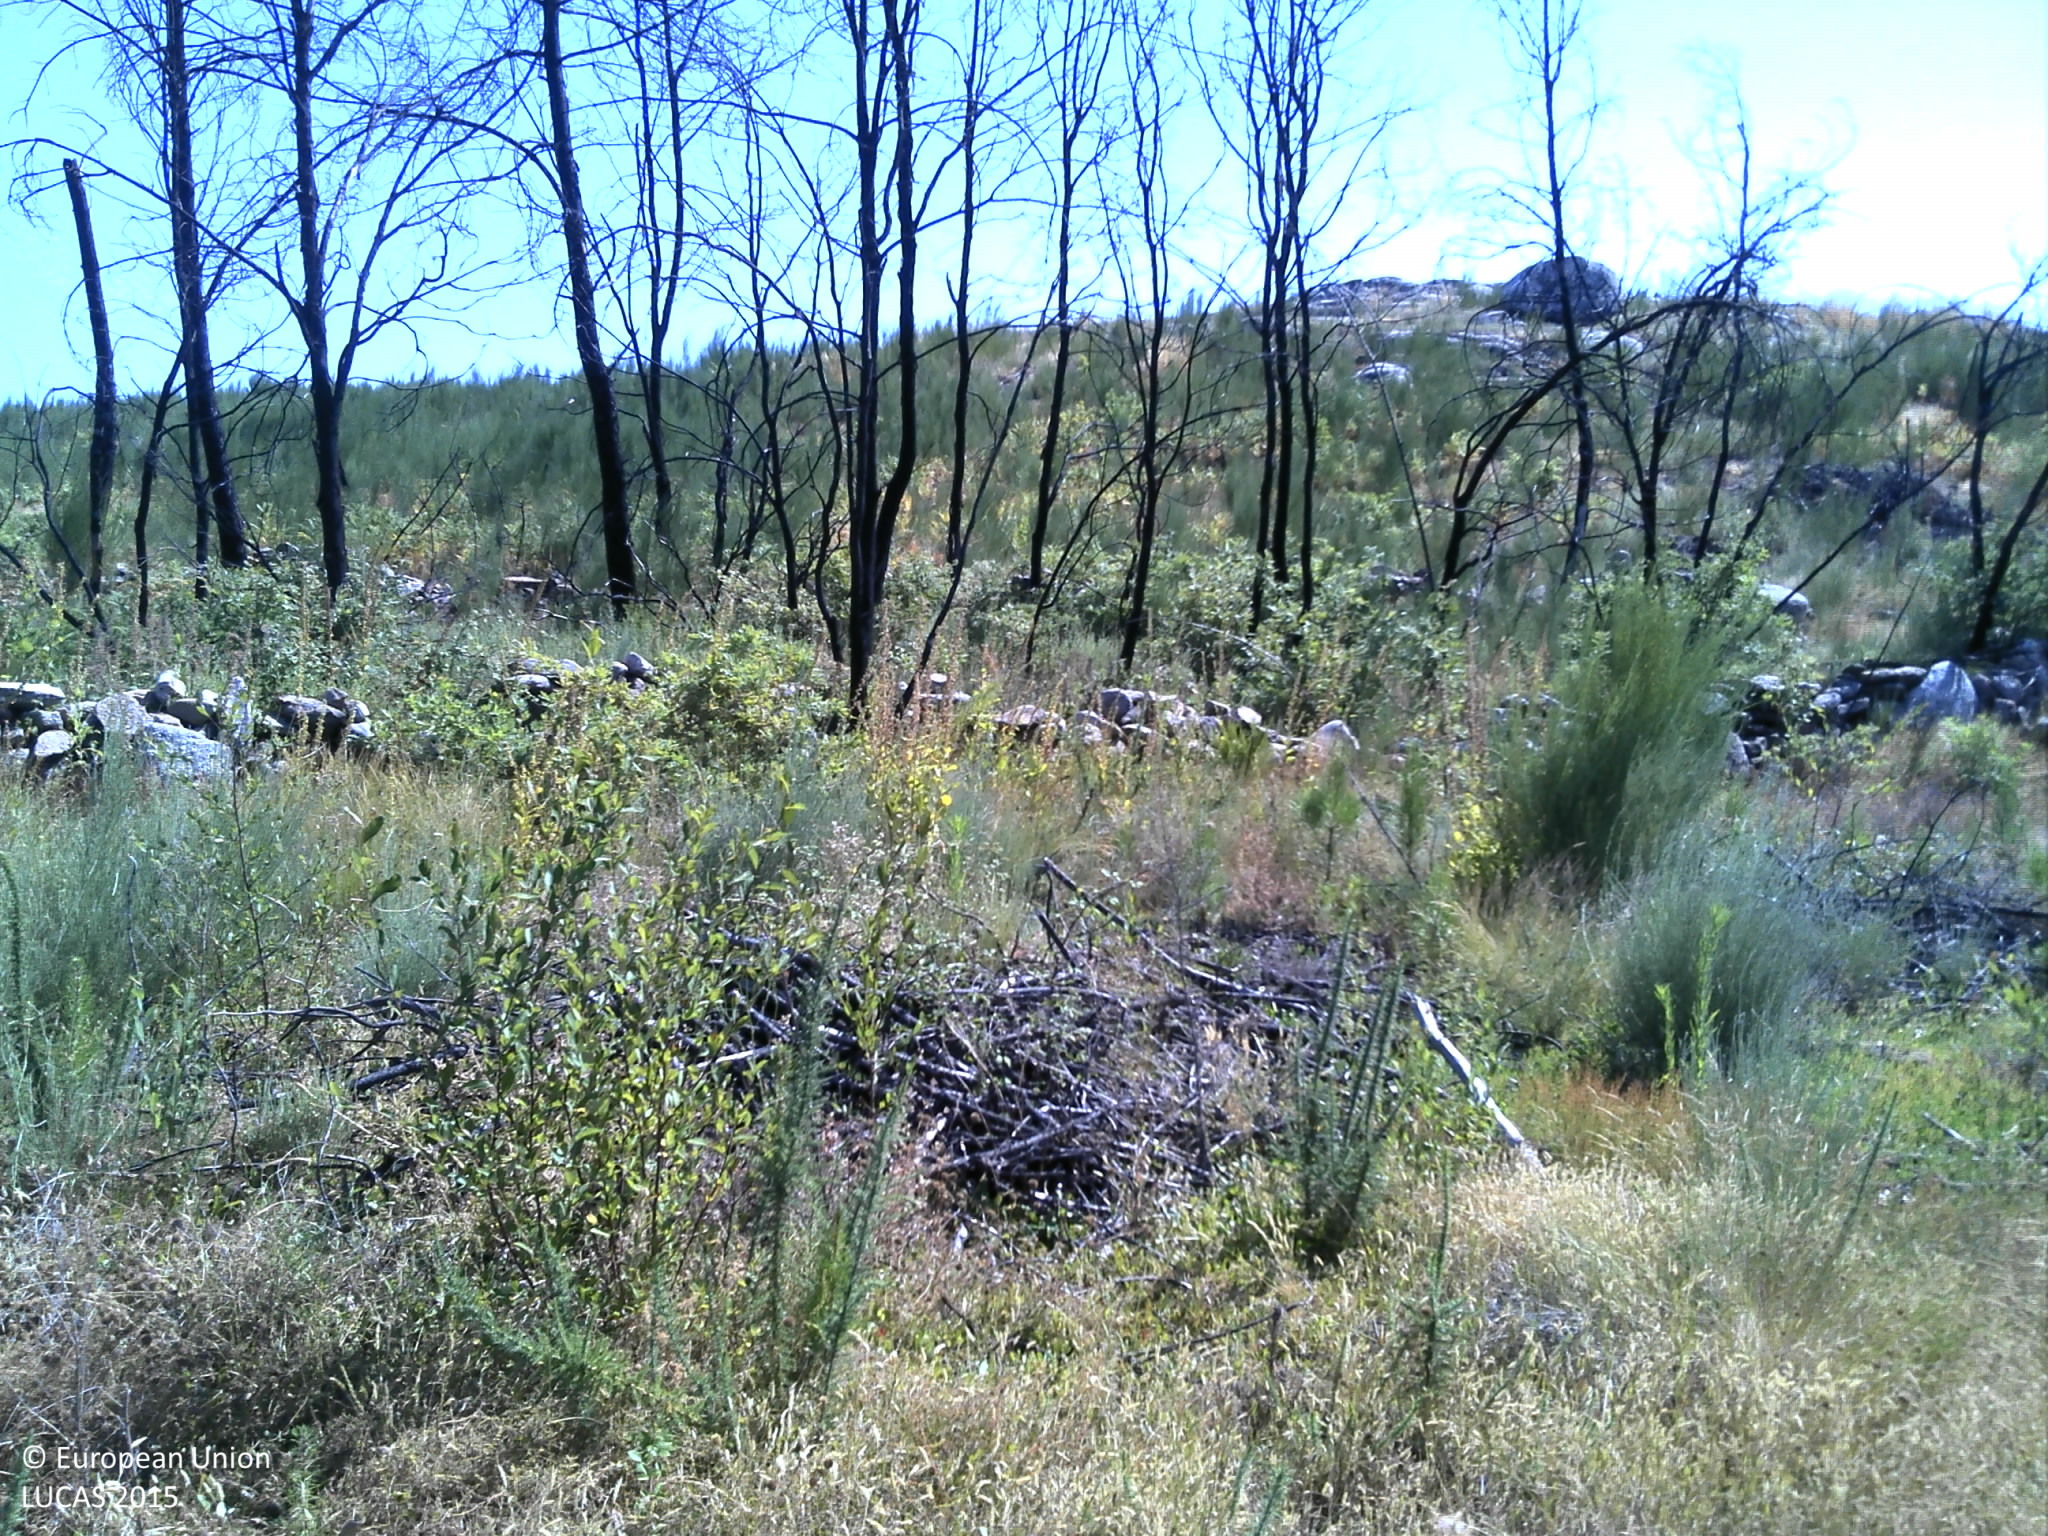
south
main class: Shrubland
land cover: Shrubland without tree cover
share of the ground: > 75 %
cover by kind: shrubs 90 %, herbaceous plants 10 %
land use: Abandoned areas
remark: Burnt area
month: July
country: PT
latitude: 40.7670
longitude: -7.4947
